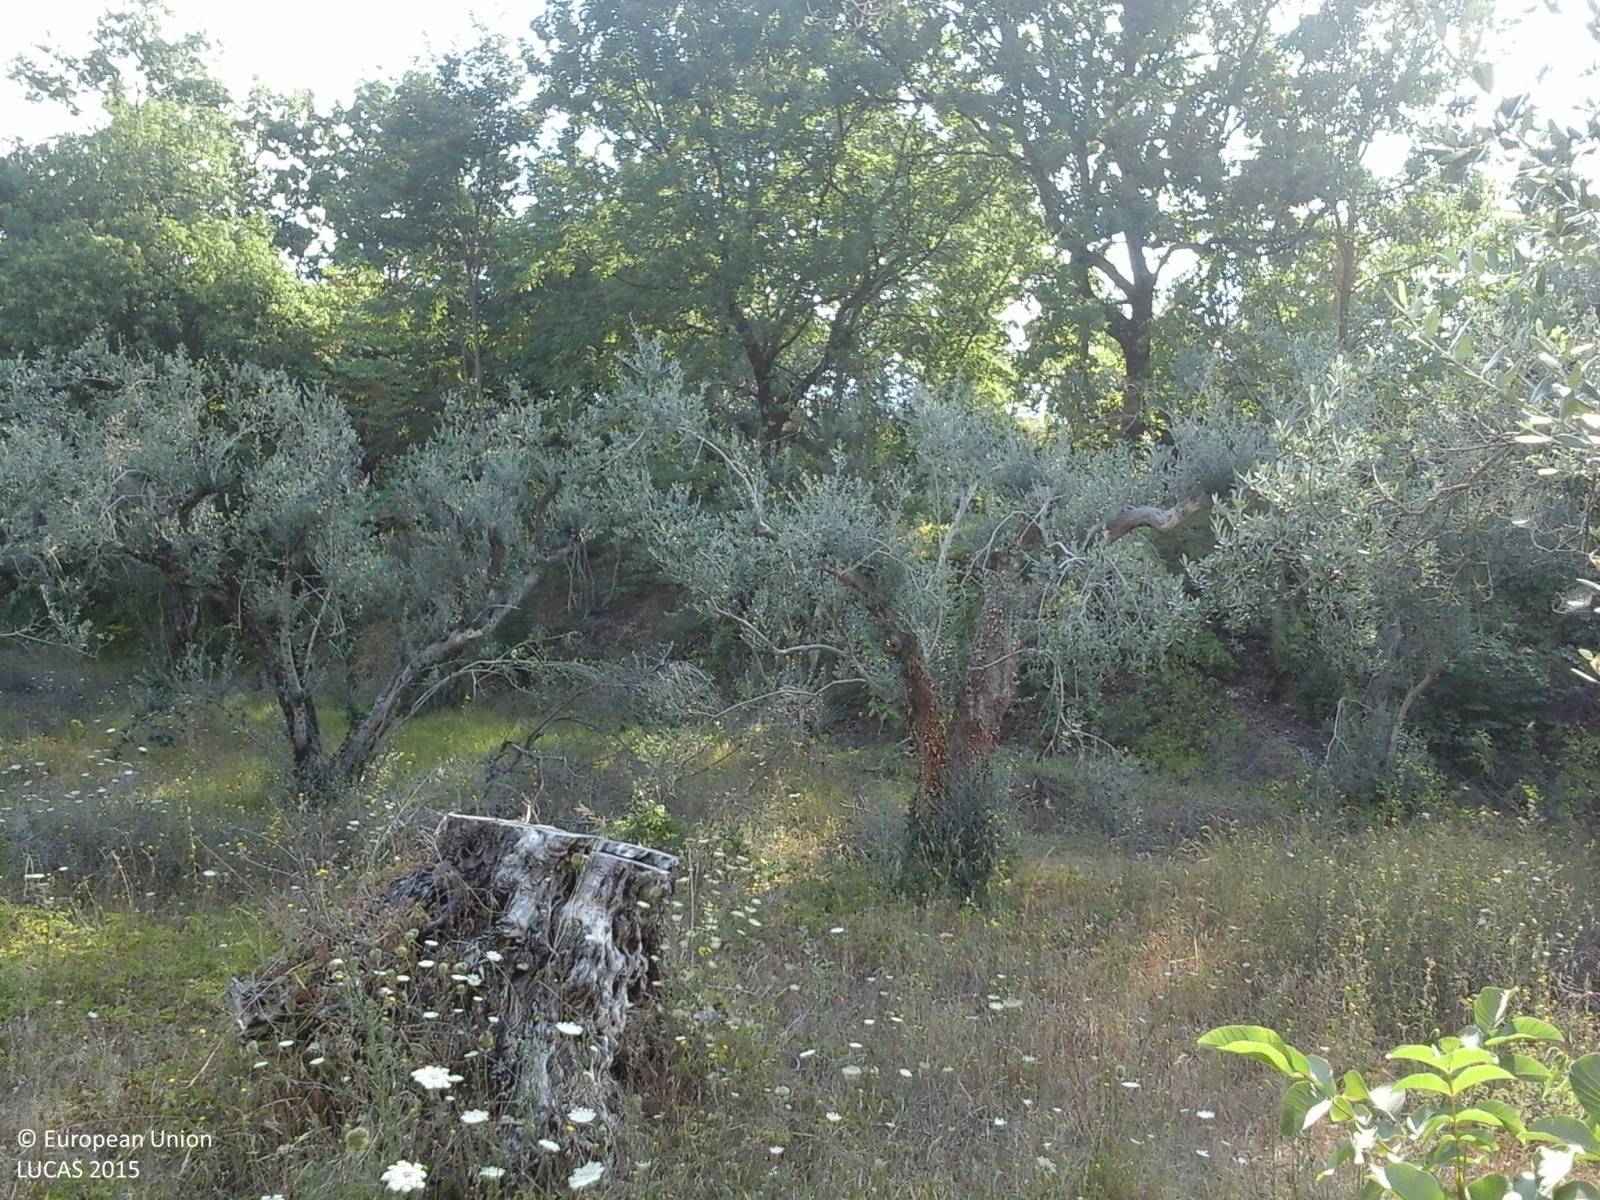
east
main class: Cropland
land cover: Olive groves
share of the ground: 50 - 75 %
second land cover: Spontaneously vegetated surfaces
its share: > 75 %
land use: Agriculture (excluding fallow land and kitchen gardens)
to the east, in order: Olive groves; Spontaneously vegetated surfaces; Broadleaved woodland; Tracks; Single bushes/trees; Spontaneously vegetated surfaces; Artificial constructions in urban areas; Ditches and canals; Fences; Lines of trees; Tracks; Electric lines; Spontaneously vegetated surfaces; Olive groves
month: August
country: IT
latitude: 41.3516
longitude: 14.2747
